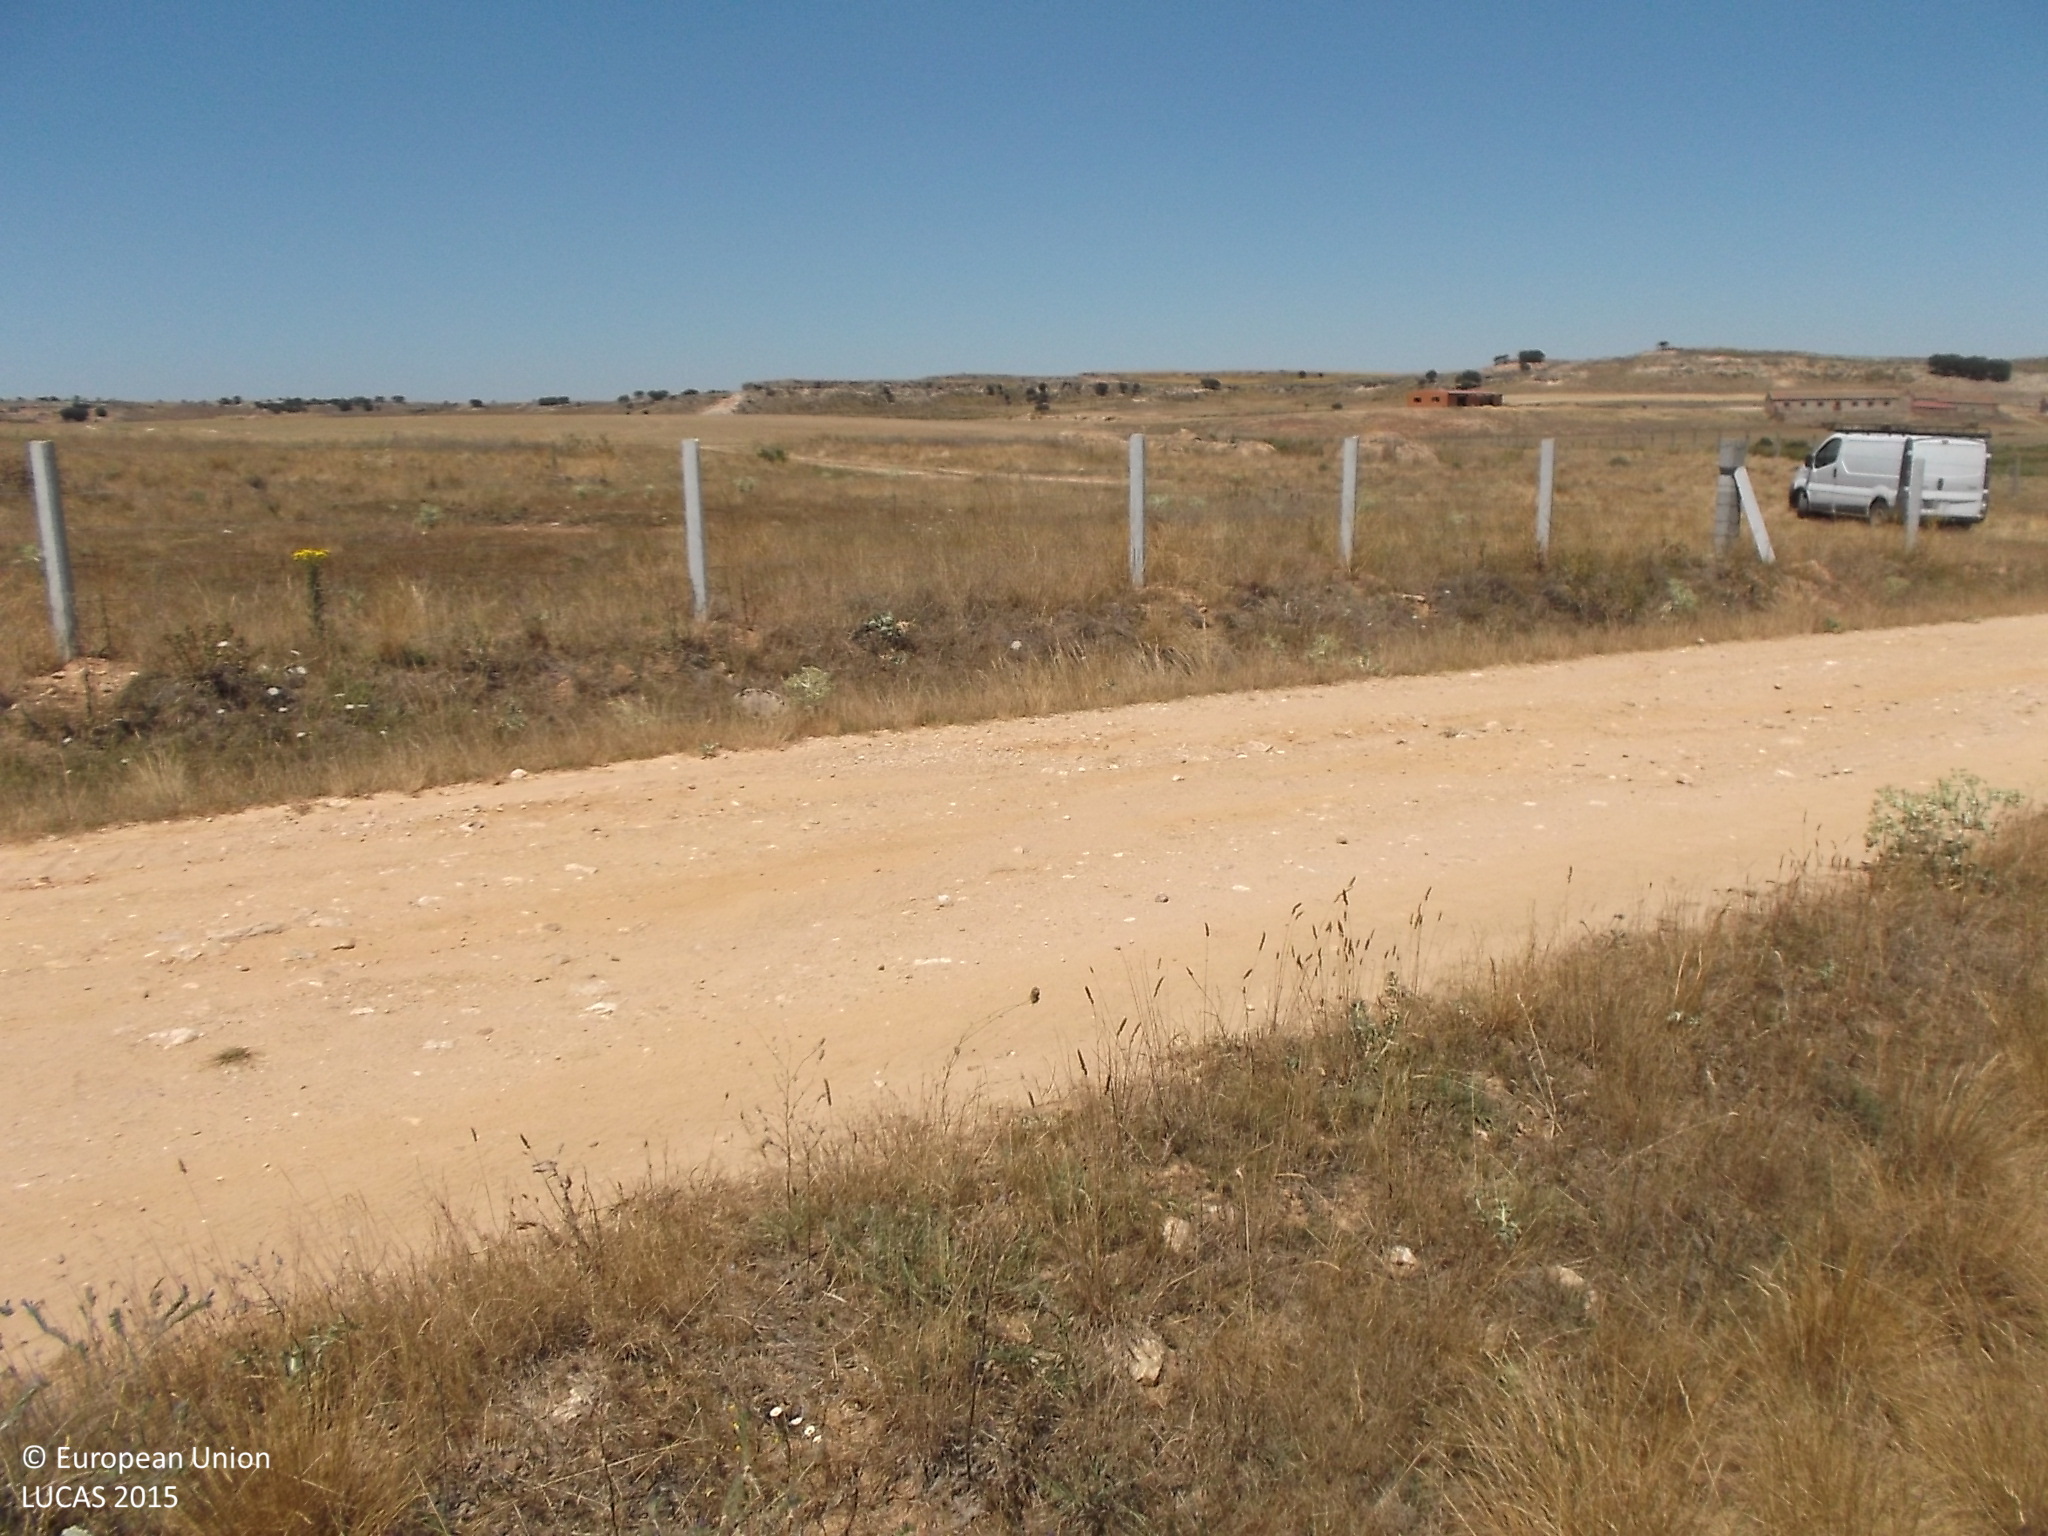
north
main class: Grassland
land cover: Grassland without tree/shrub cover
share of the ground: > 75 %
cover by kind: herbaceous plants 100 %
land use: Agriculture (excluding fallow land and kitchen gardens)
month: July
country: ES
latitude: 41.4022
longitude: -5.8159
